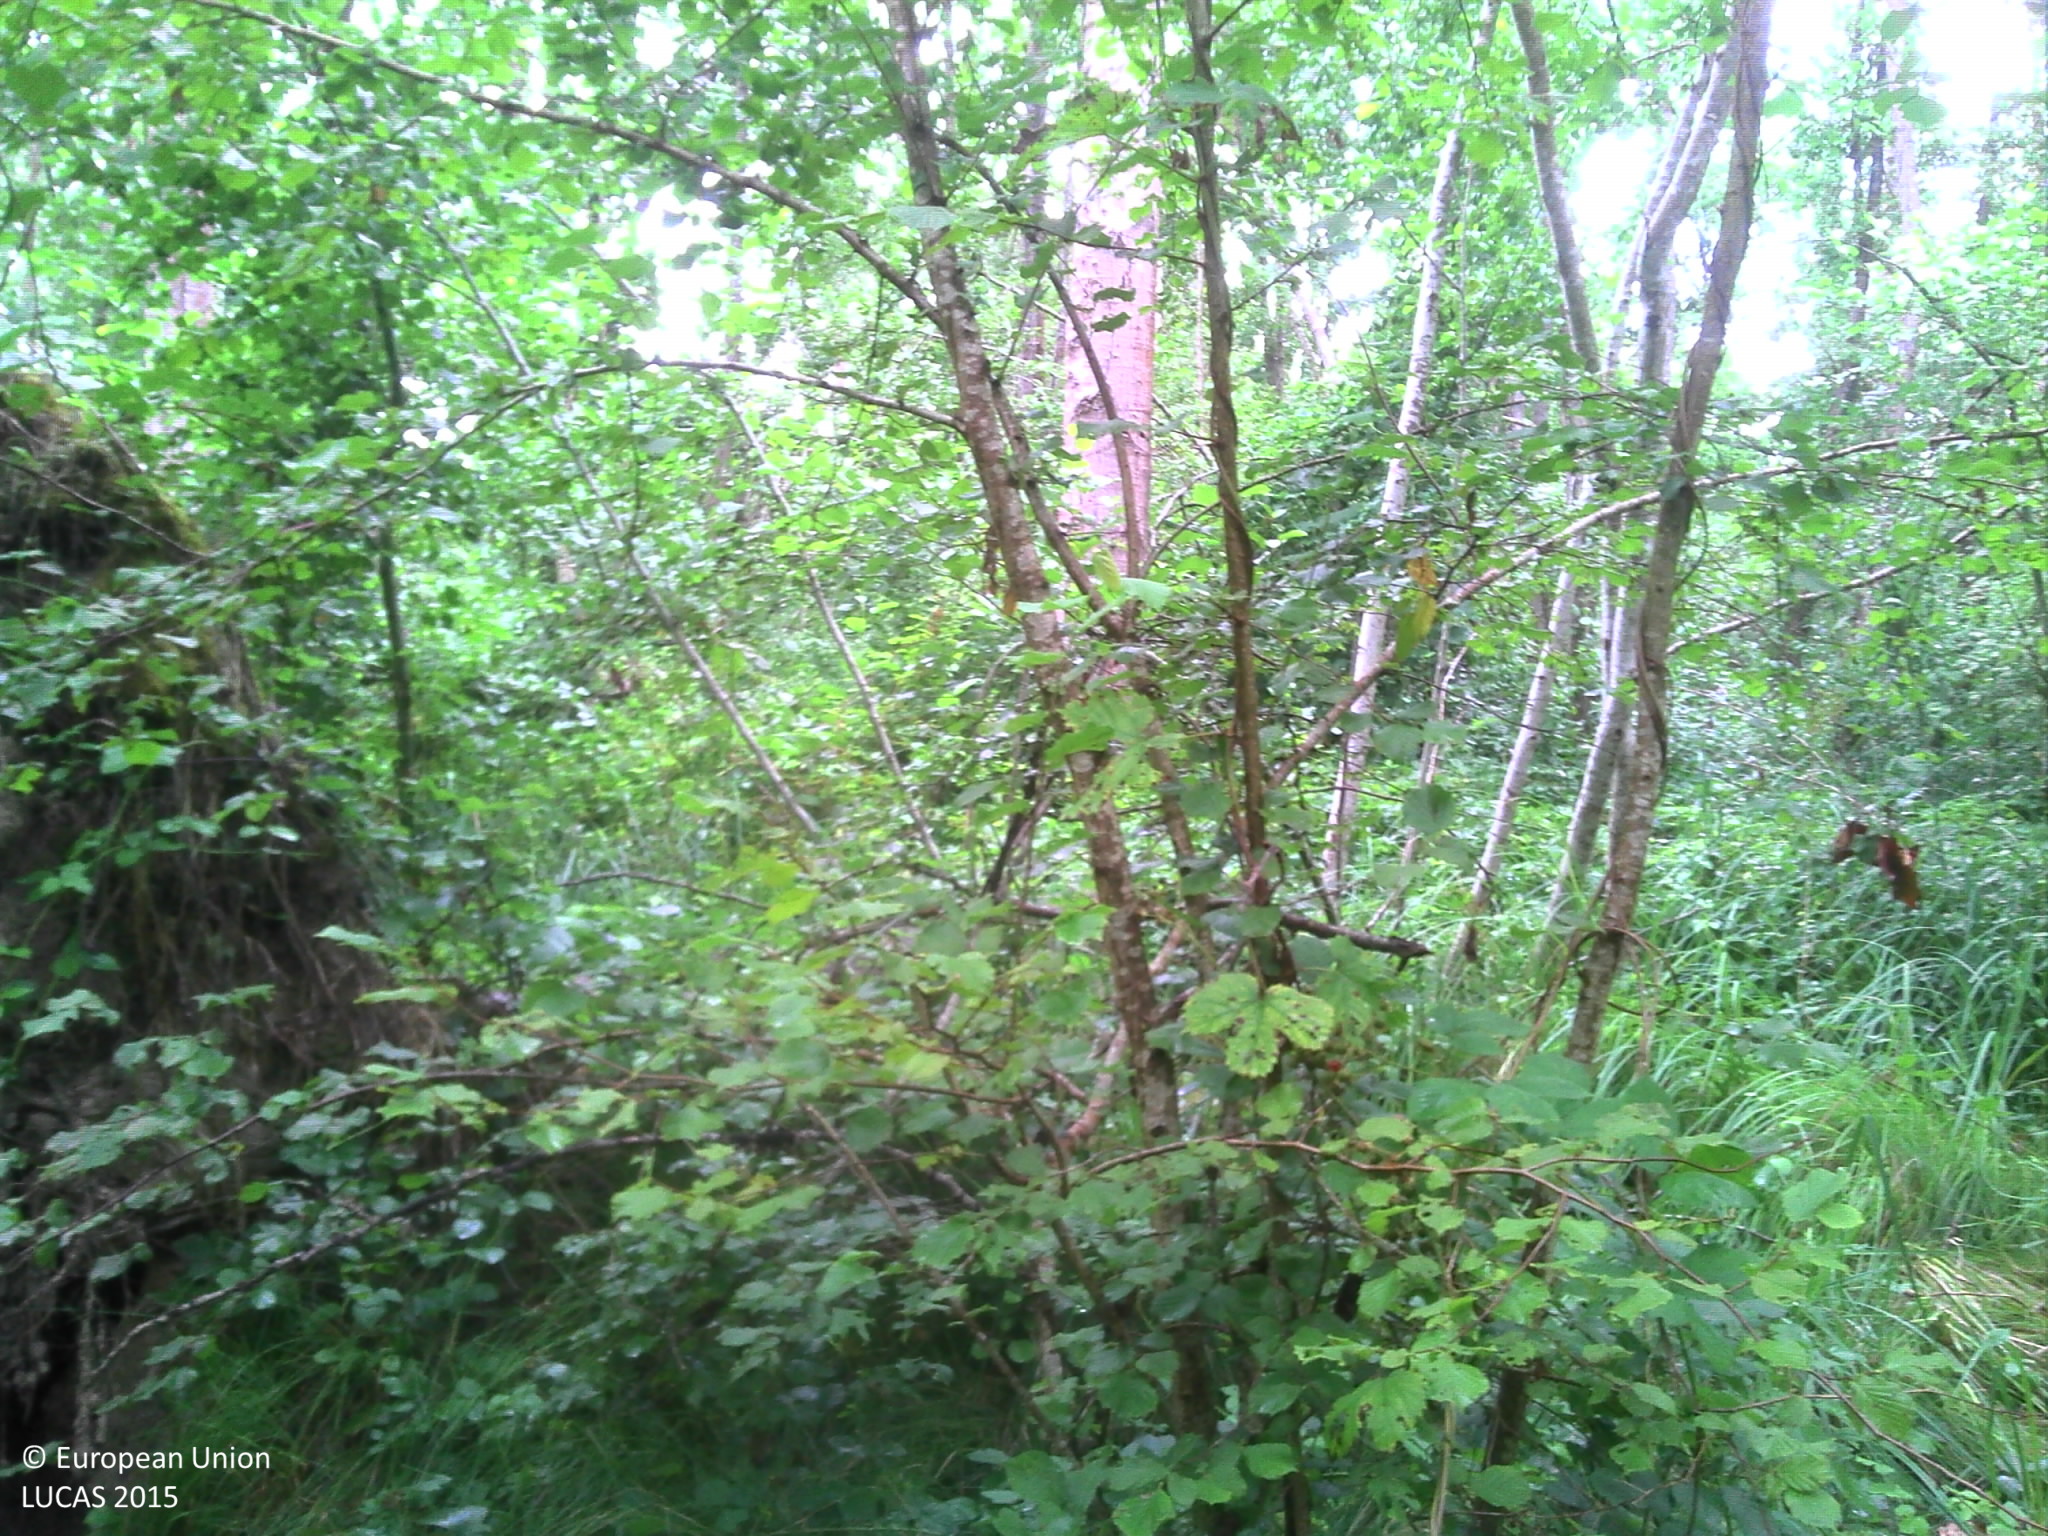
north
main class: Woodland
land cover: Broadleaved woodland
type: non-riverine alder, birch or aspen forest
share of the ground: > 75 %
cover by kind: broadleaved forest trees 75 %, herbaceous plants 20 %, shrubs 5 %
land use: Forestry
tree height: > 5 m
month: July
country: FR
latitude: 46.7223
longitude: 5.0168
